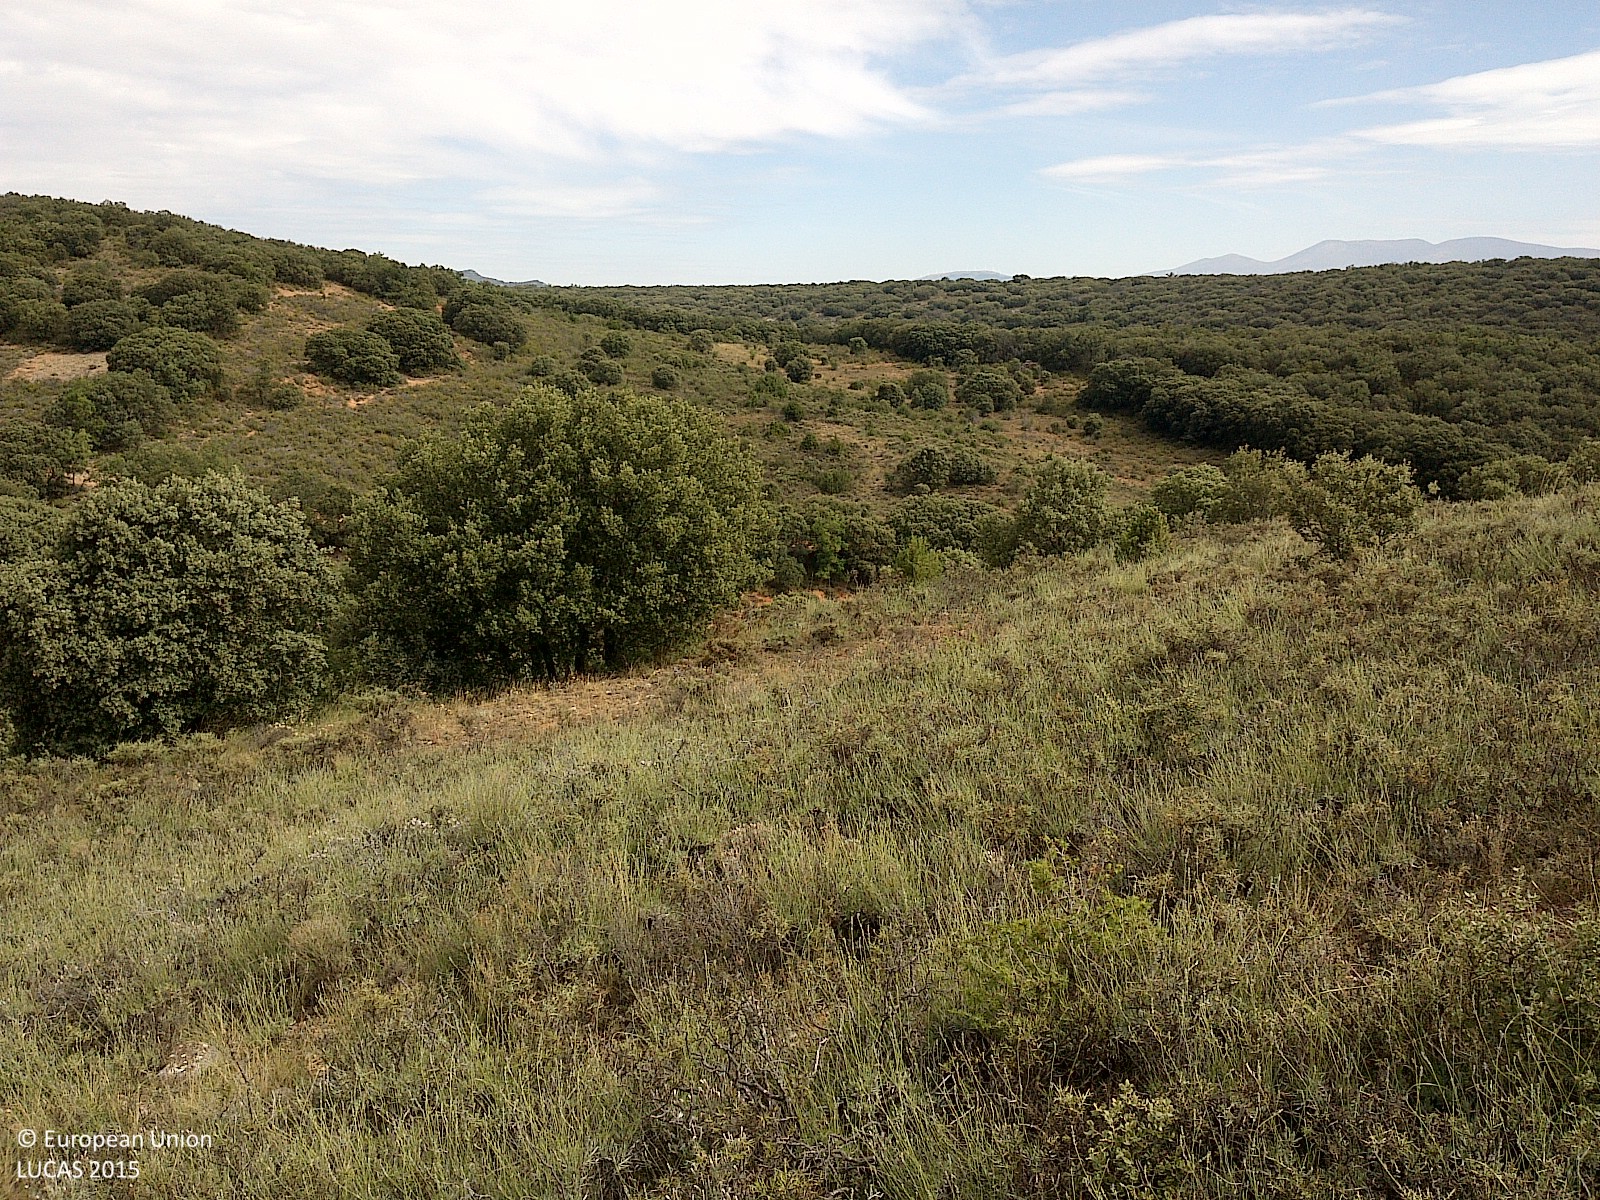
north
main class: Shrubland
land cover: Shrubland with sparse tree cover
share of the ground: > 75 %
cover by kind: shrubs 85 %, herbaceous plants 10 %, broadleaved forest trees 5 %
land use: Semi-natural and natural areas not in use
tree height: < 5 m
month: July
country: ES
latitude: 41.5416
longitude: -1.9574
